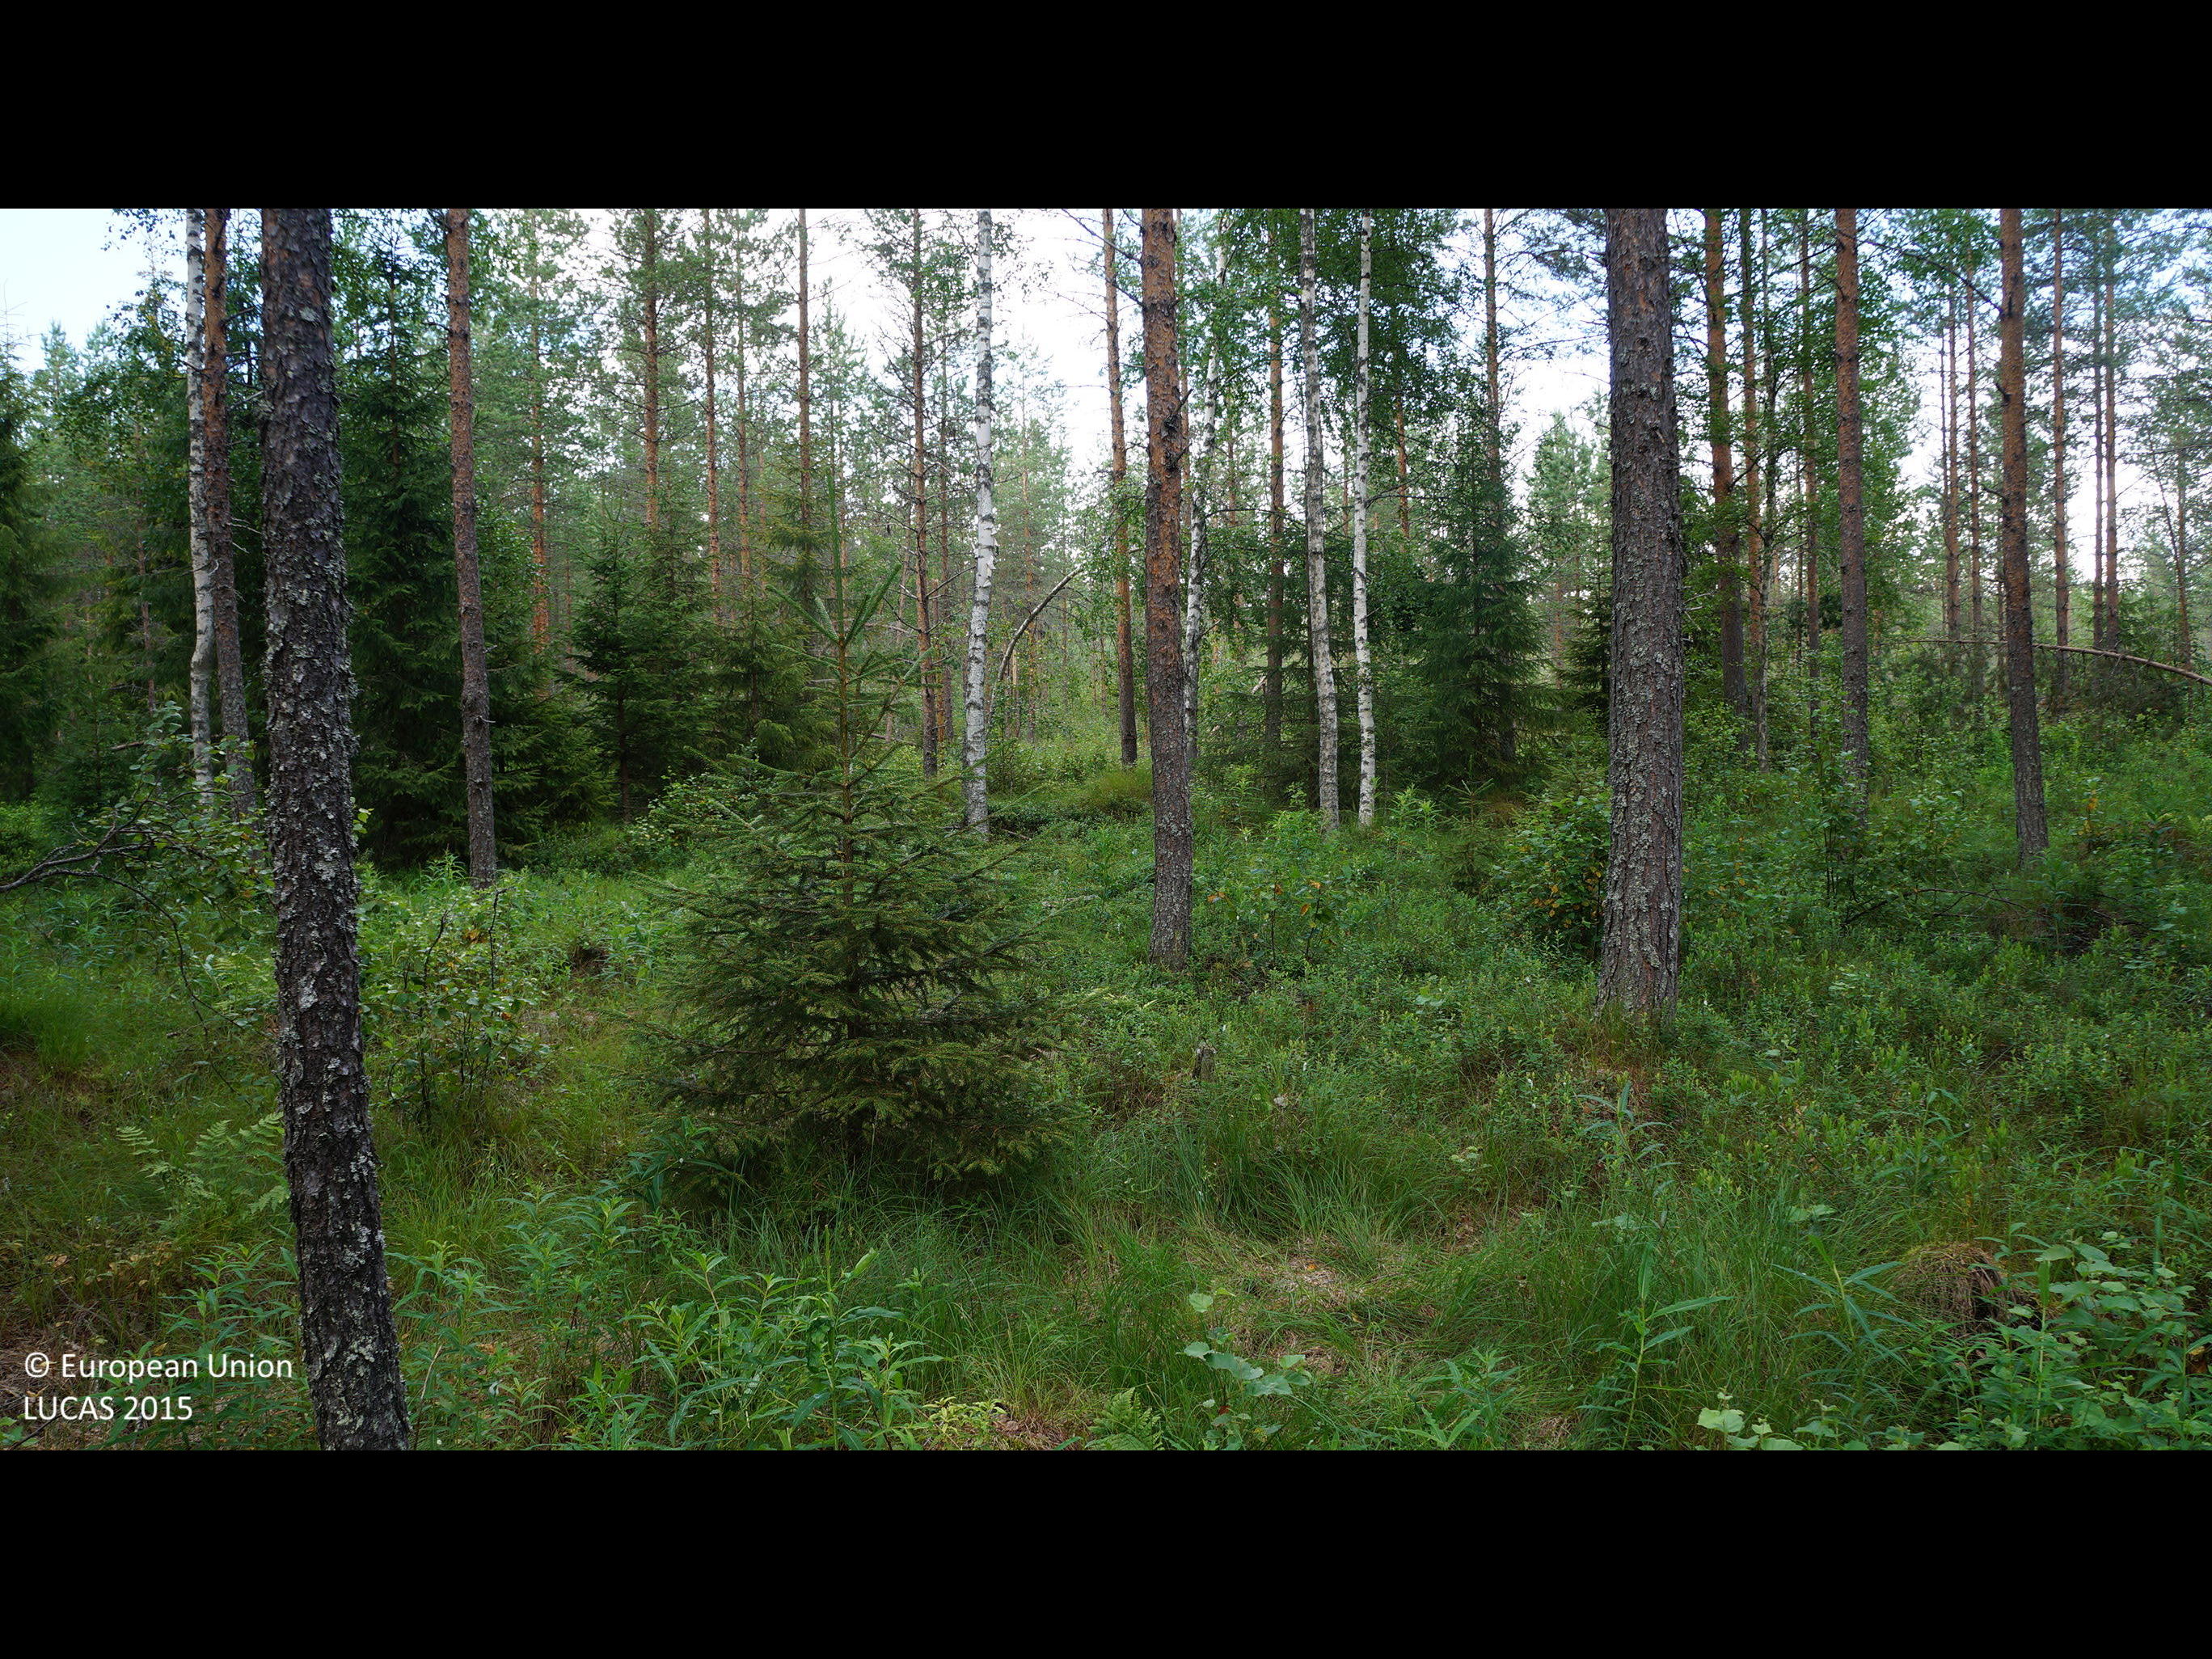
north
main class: Woodland
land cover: Pine dominated mixed woodland
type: boreal forest
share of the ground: 50 - 75 %
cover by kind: coniferous forest trees 30 %, herbaceous plants 30 %, broadleaved forest trees 20 %, shrubs 20 %
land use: Forestry
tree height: > 5 m
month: July
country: FI
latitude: 64.0157
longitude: 24.3717
